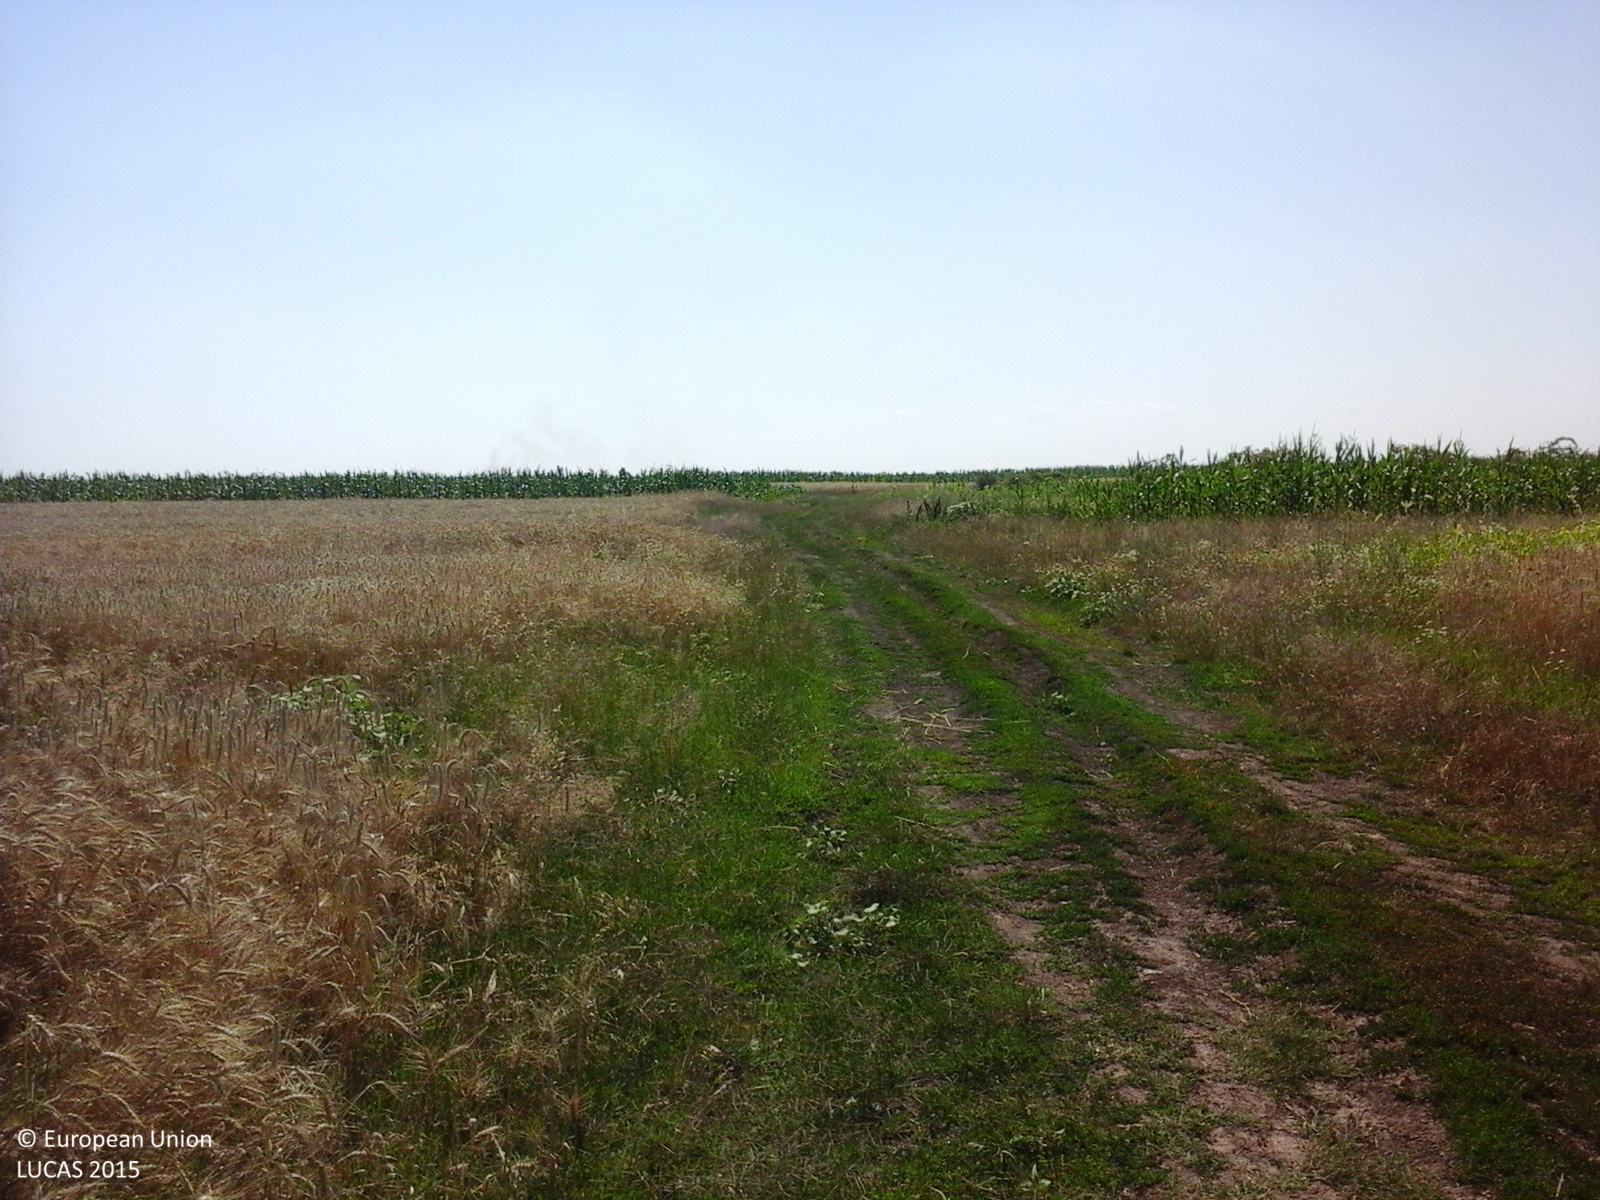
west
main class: Cropland
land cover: Common wheat
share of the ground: > 75 %
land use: Agriculture (excluding fallow land and kitchen gardens)
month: July
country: RO
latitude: 44.3707
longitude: 24.6168
